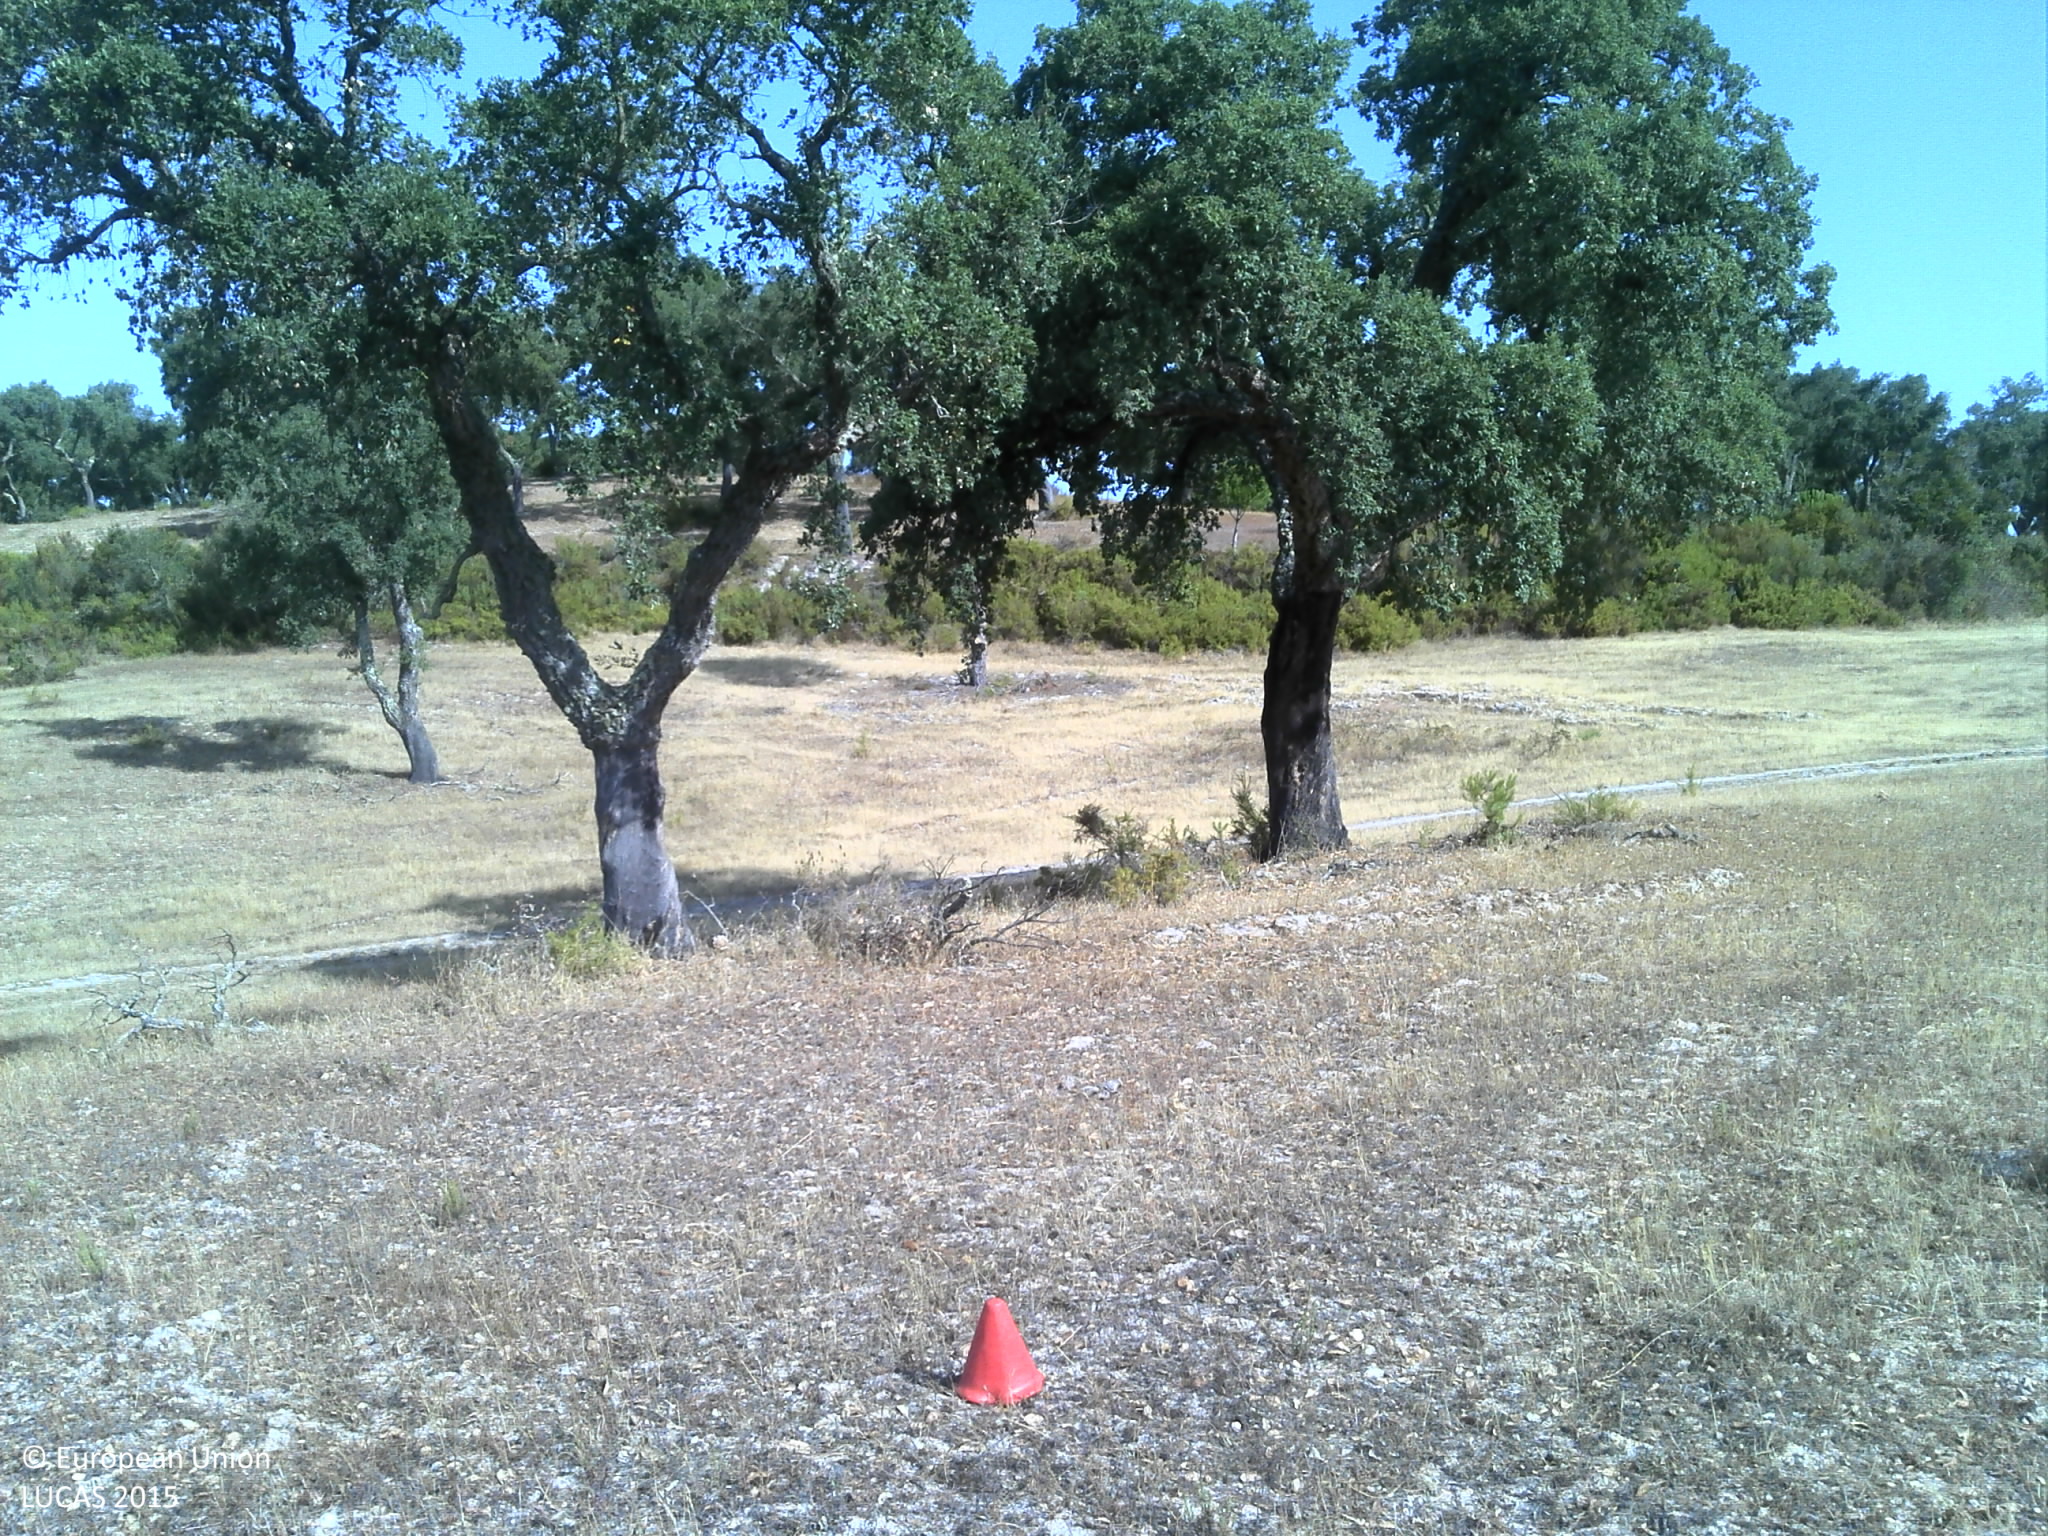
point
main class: Woodland
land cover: Broadleaved woodland
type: broadleaved evergreen forest
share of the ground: 25 - 50 %
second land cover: Grassland without tree/shrub cover
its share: 25 - 50 %
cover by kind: herbaceous plants 40 %, broadleaved forest trees 30 %, unconsolidated bare surface 30 %
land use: Forestry
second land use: Agriculture (excluding fallow land and kitchen gardens)
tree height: > 5 m
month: July
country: PT
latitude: 39.1170
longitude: -8.3228
